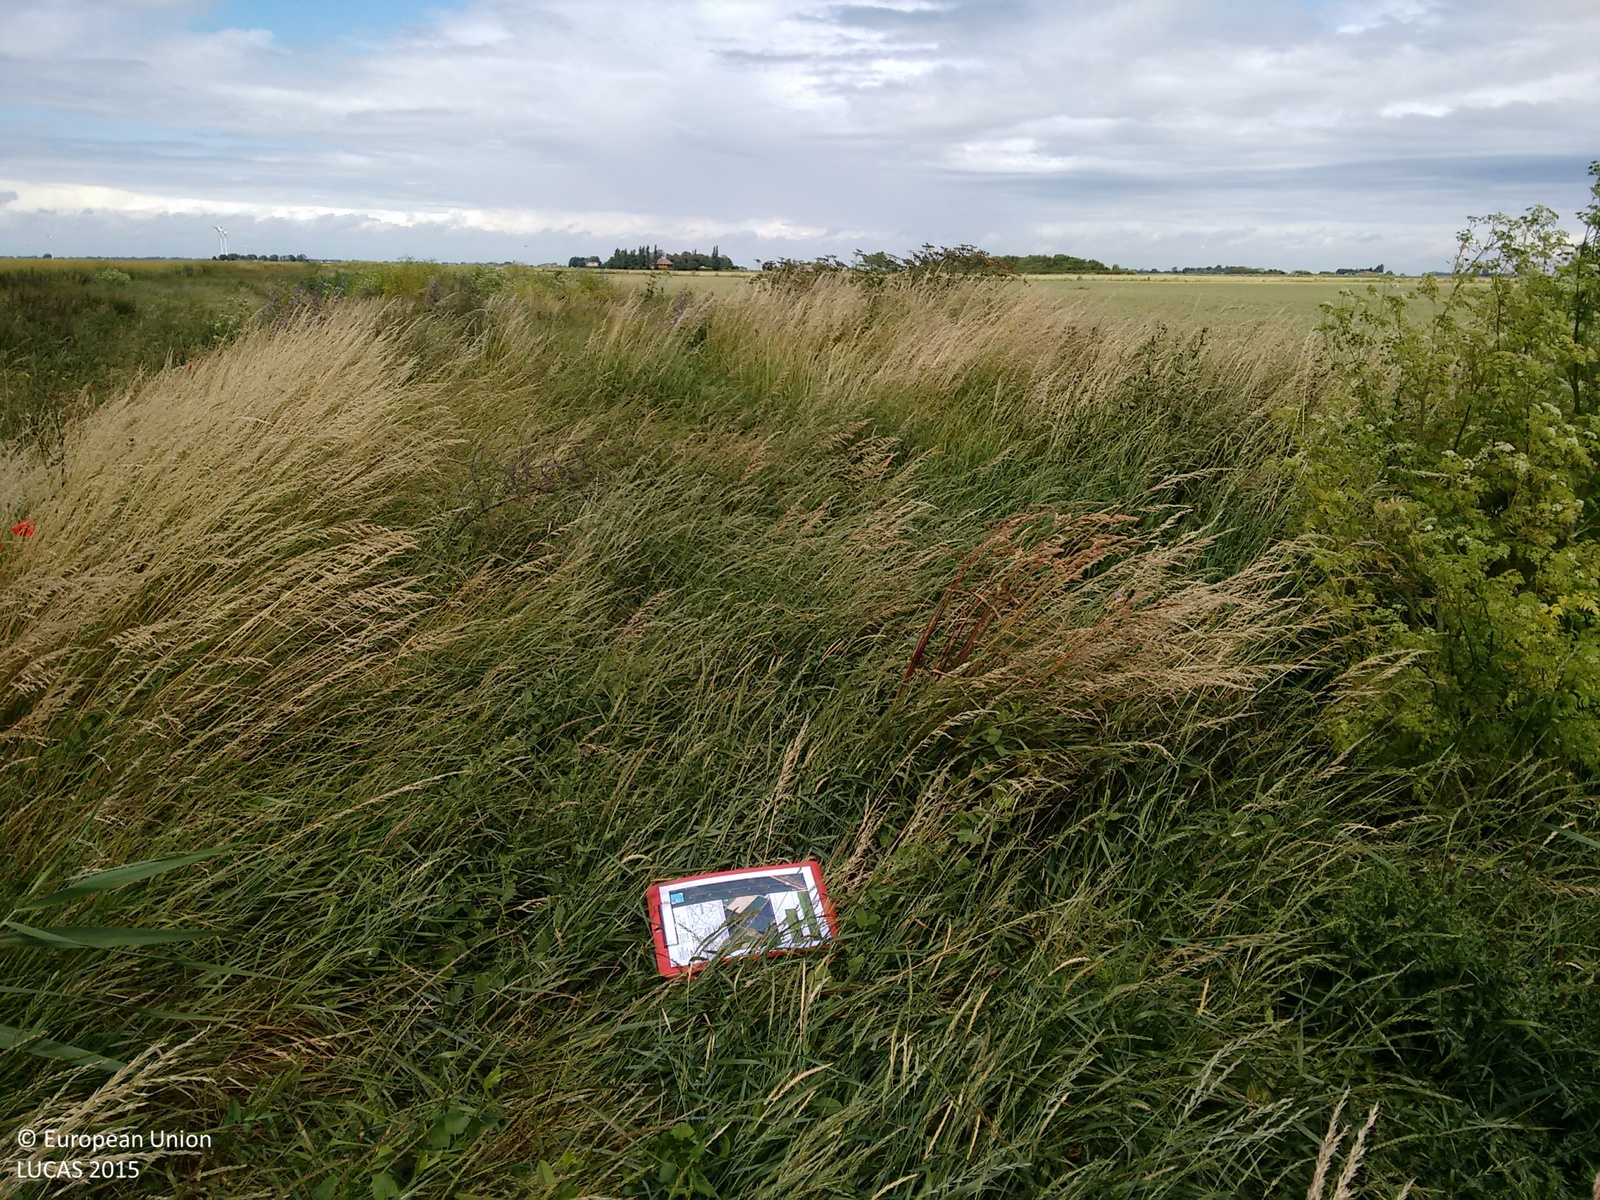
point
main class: Grassland
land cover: Grassland without tree/shrub cover
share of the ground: > 75 %
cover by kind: herbaceous plants 100 %
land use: Agriculture (excluding fallow land and kitchen gardens)
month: July
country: GB
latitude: 52.4263
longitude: 0.0115
